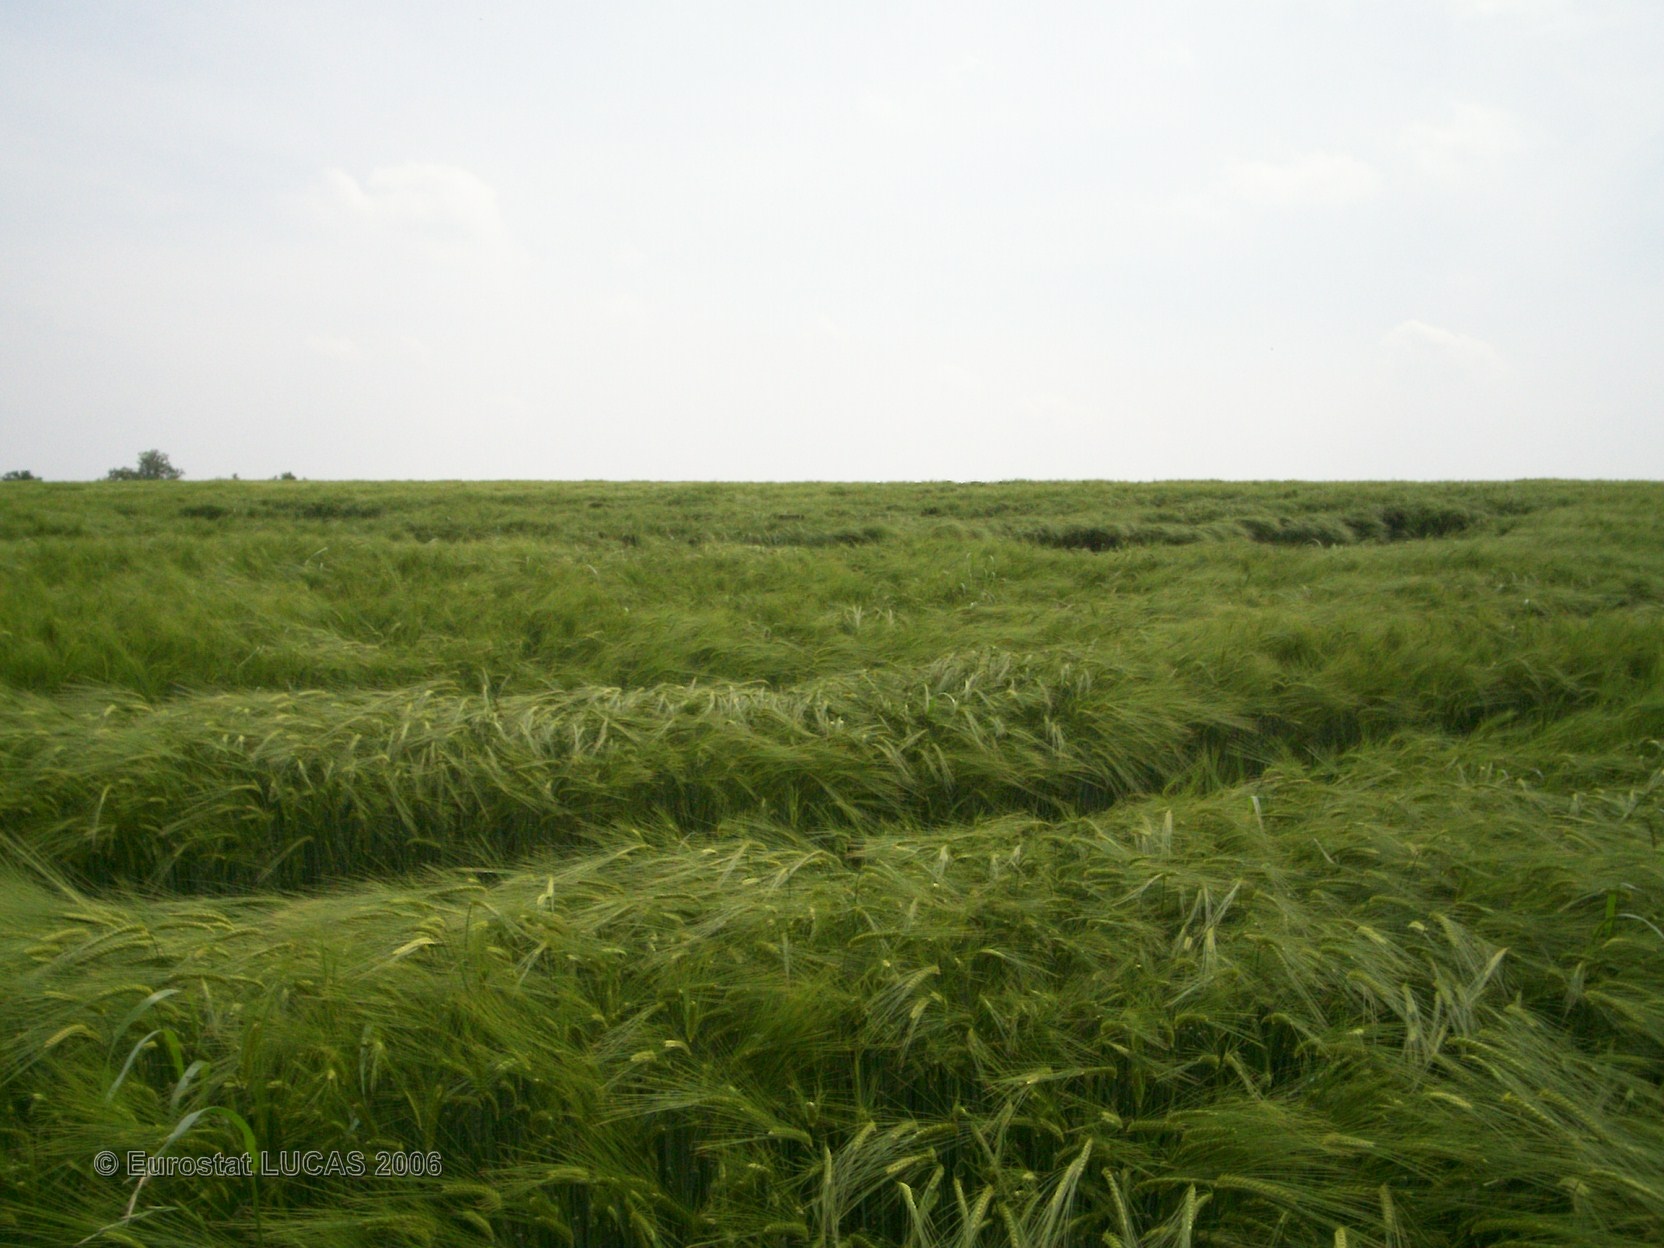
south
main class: Cropland
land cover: Barley
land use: Agriculture (excluding fallow land and kitchen gardens)
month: May
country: FR
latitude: 46.6322
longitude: -0.8593
